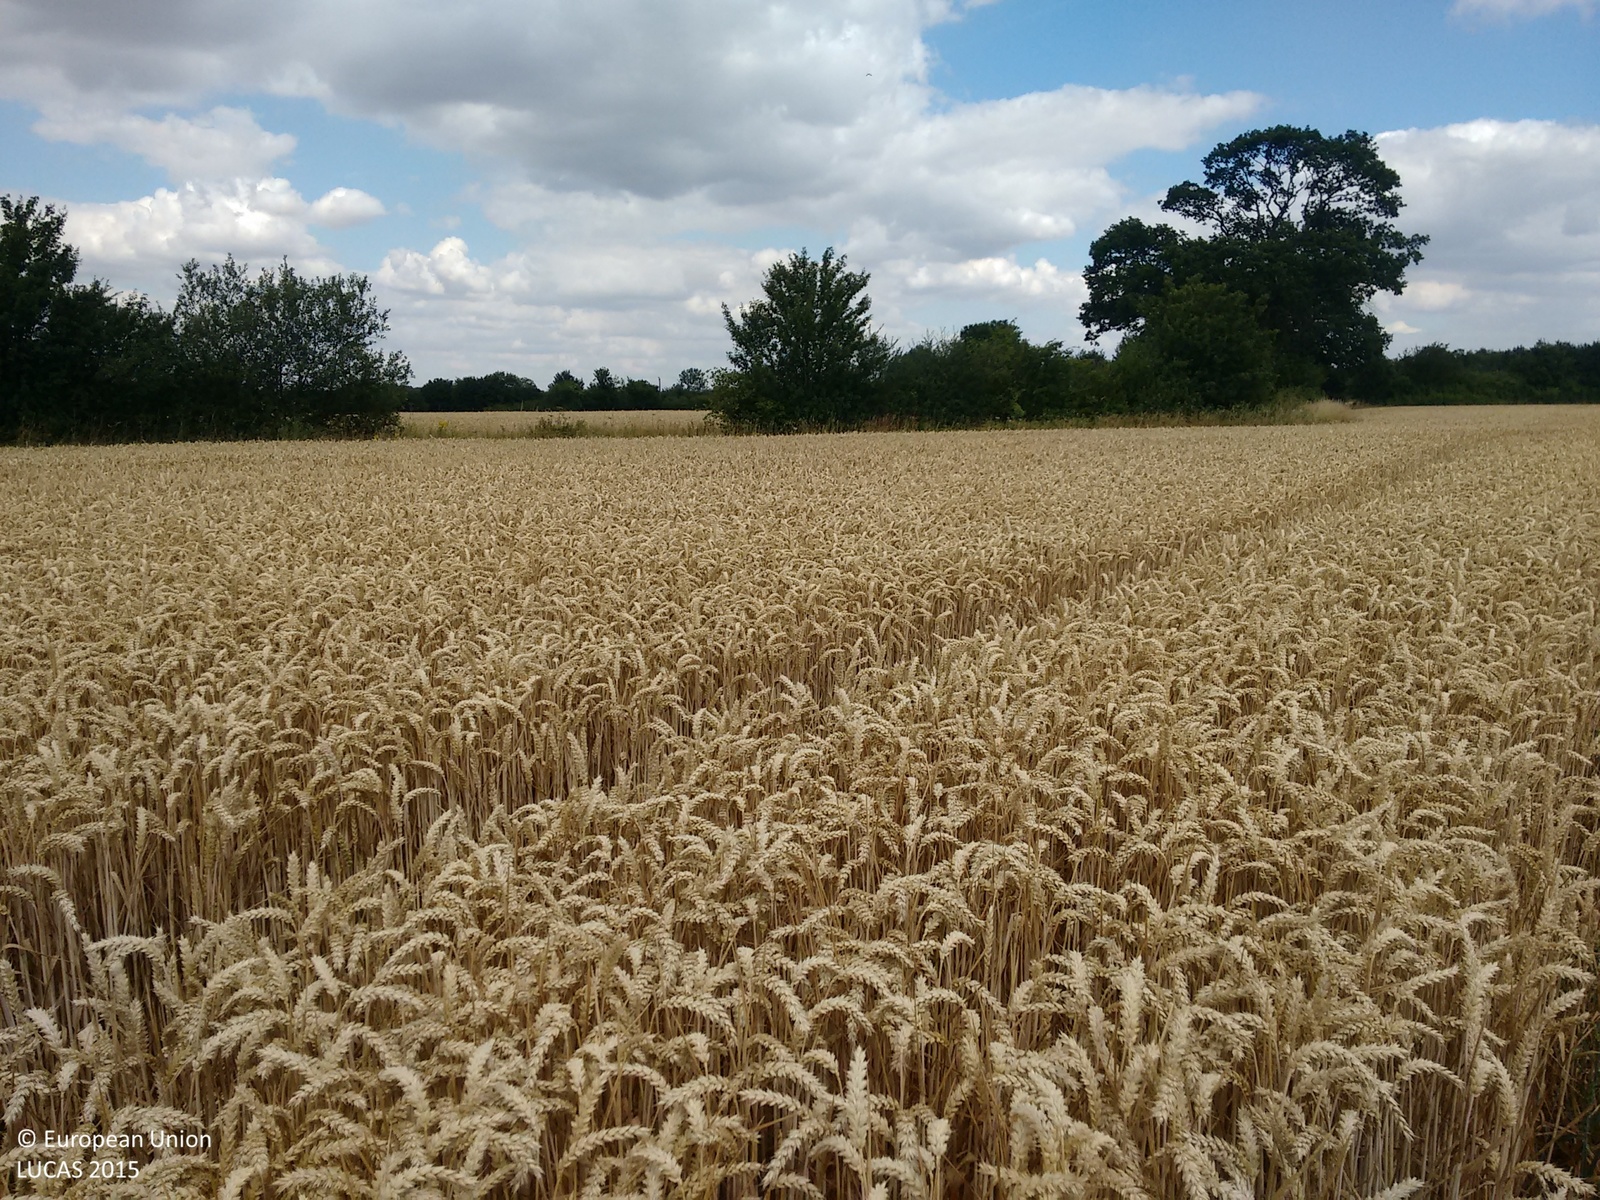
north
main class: Cropland
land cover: Common wheat
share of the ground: > 75 %
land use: Agriculture (excluding fallow land and kitchen gardens)
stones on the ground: < 10 %
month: July
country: GB
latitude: 51.8681
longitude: 0.4885
